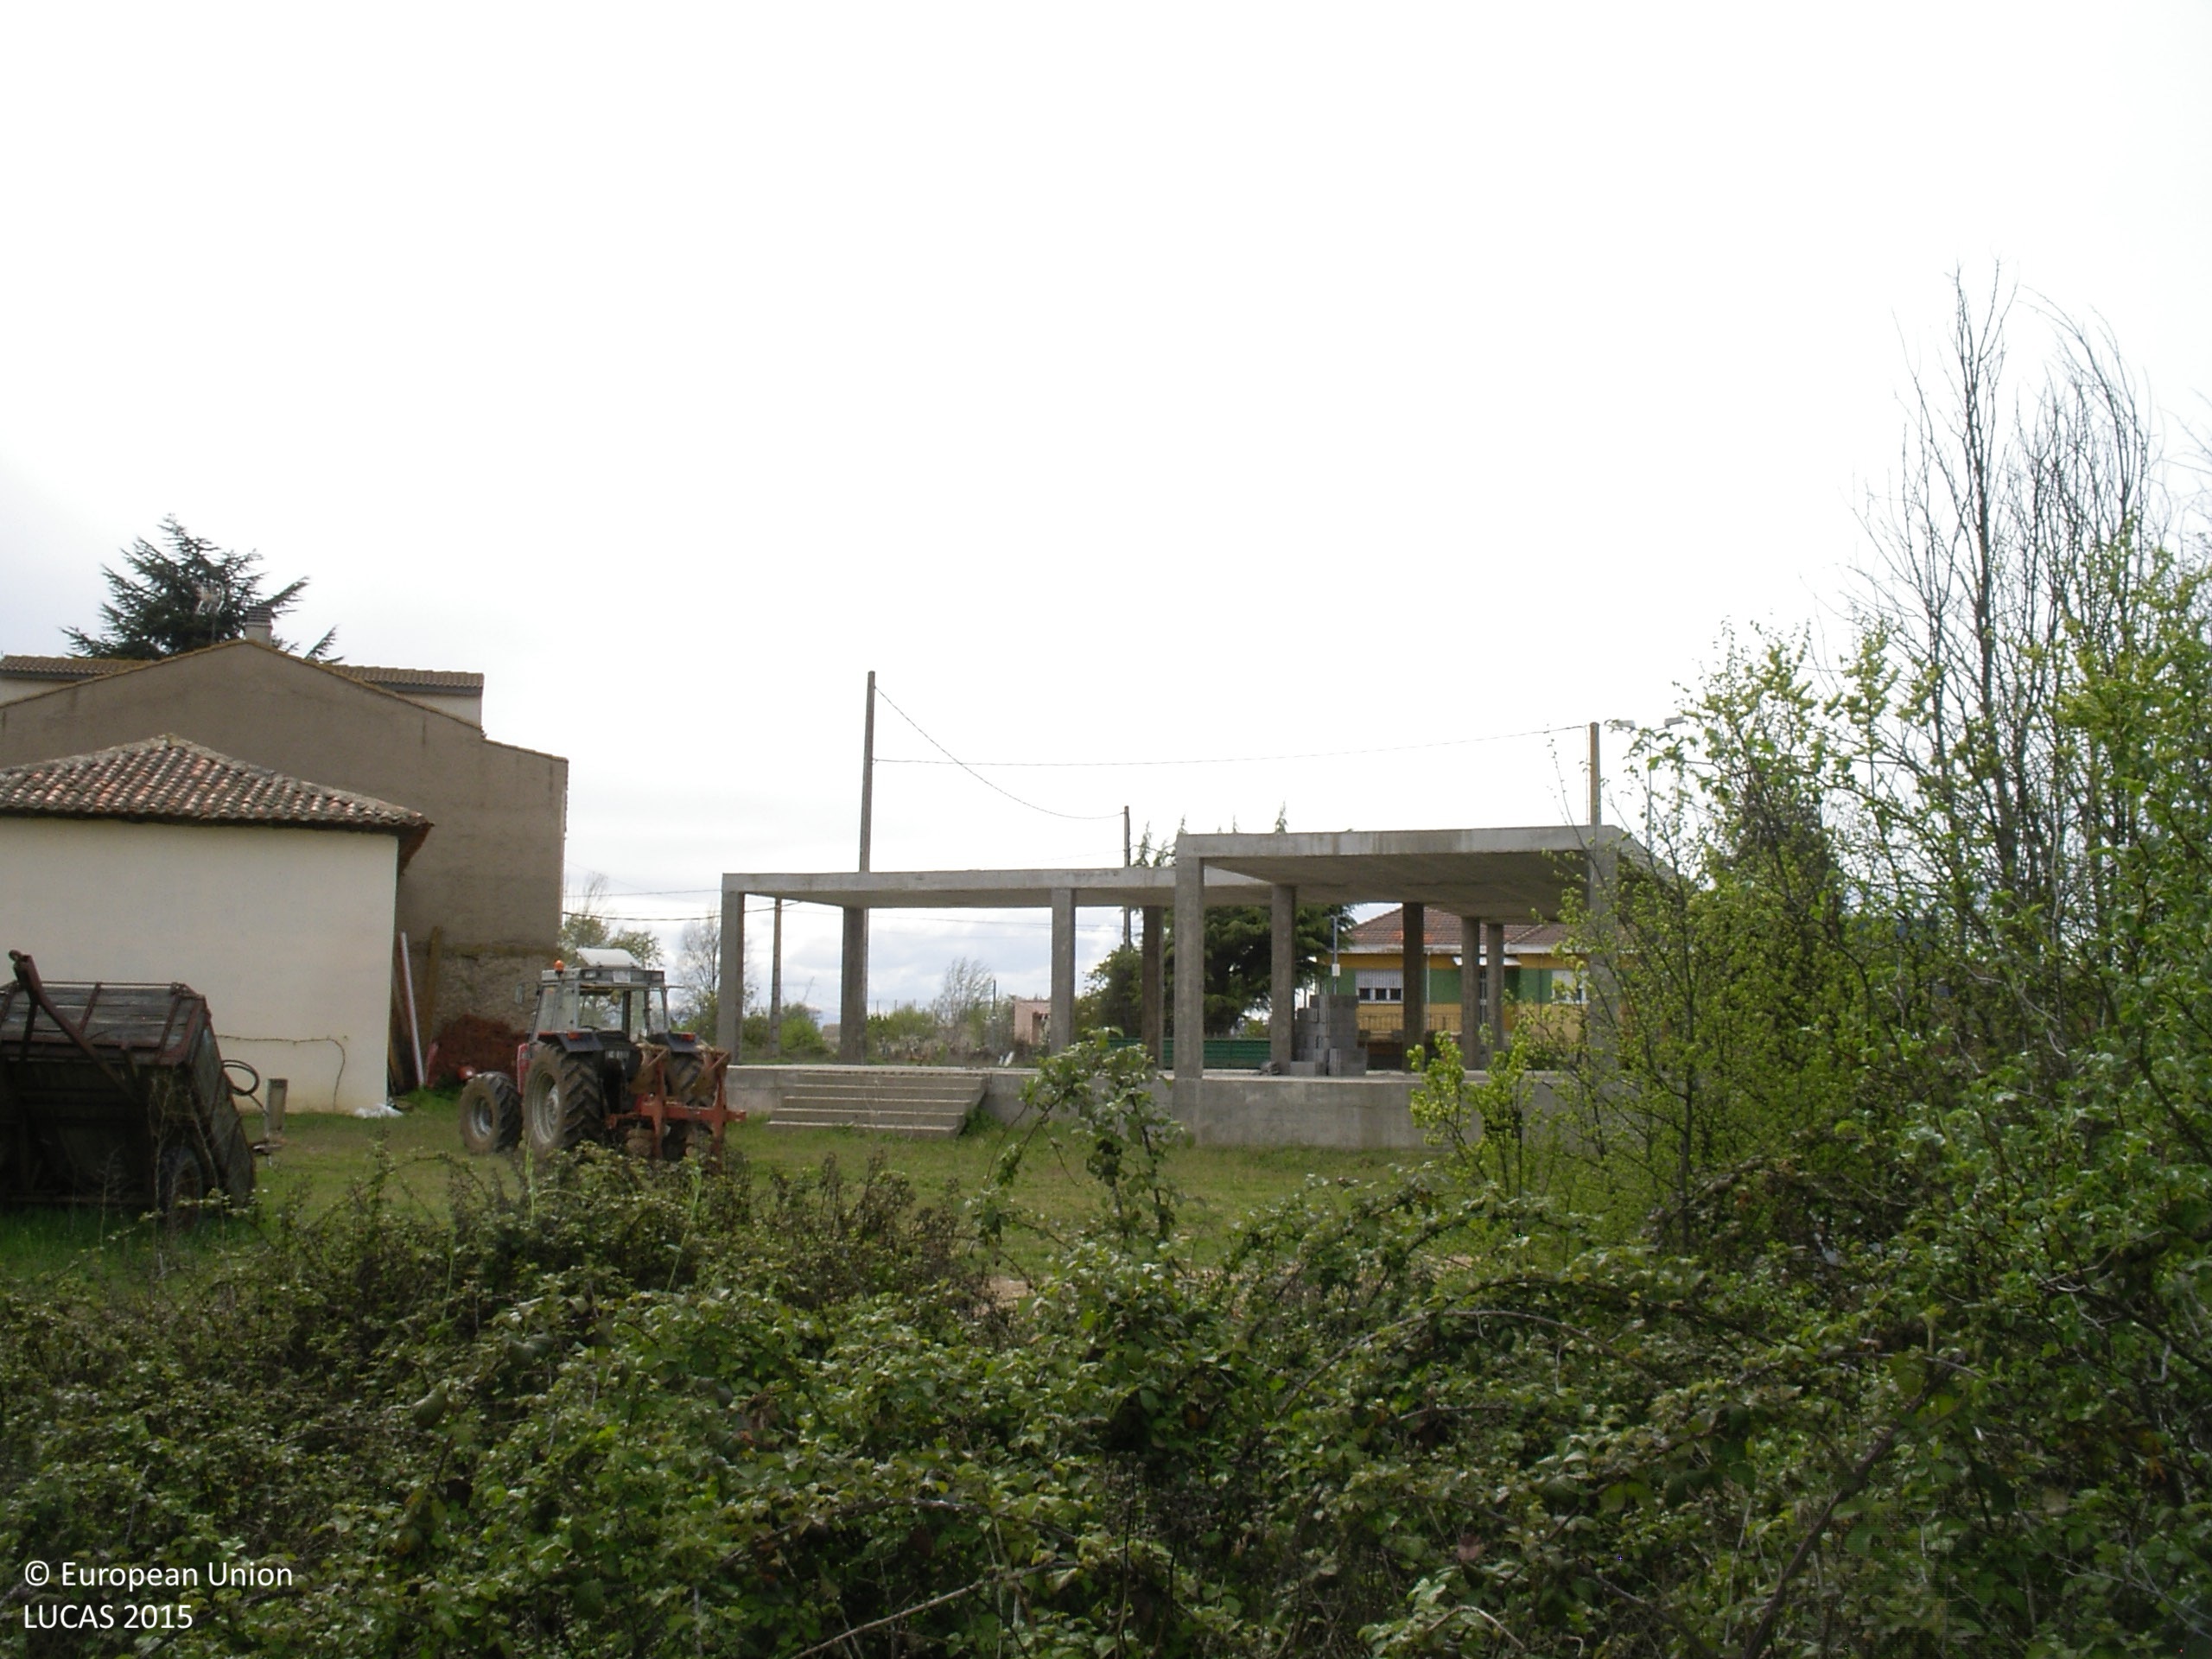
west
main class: Grassland
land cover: Grassland with sparse tree/shrub cover
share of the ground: > 75 %
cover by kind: herbaceous plants 90 %, broadleaved forest trees 5 %, shrubs 5 %
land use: Abandoned areas
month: April
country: ES
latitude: 42.4809
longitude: -5.7309
